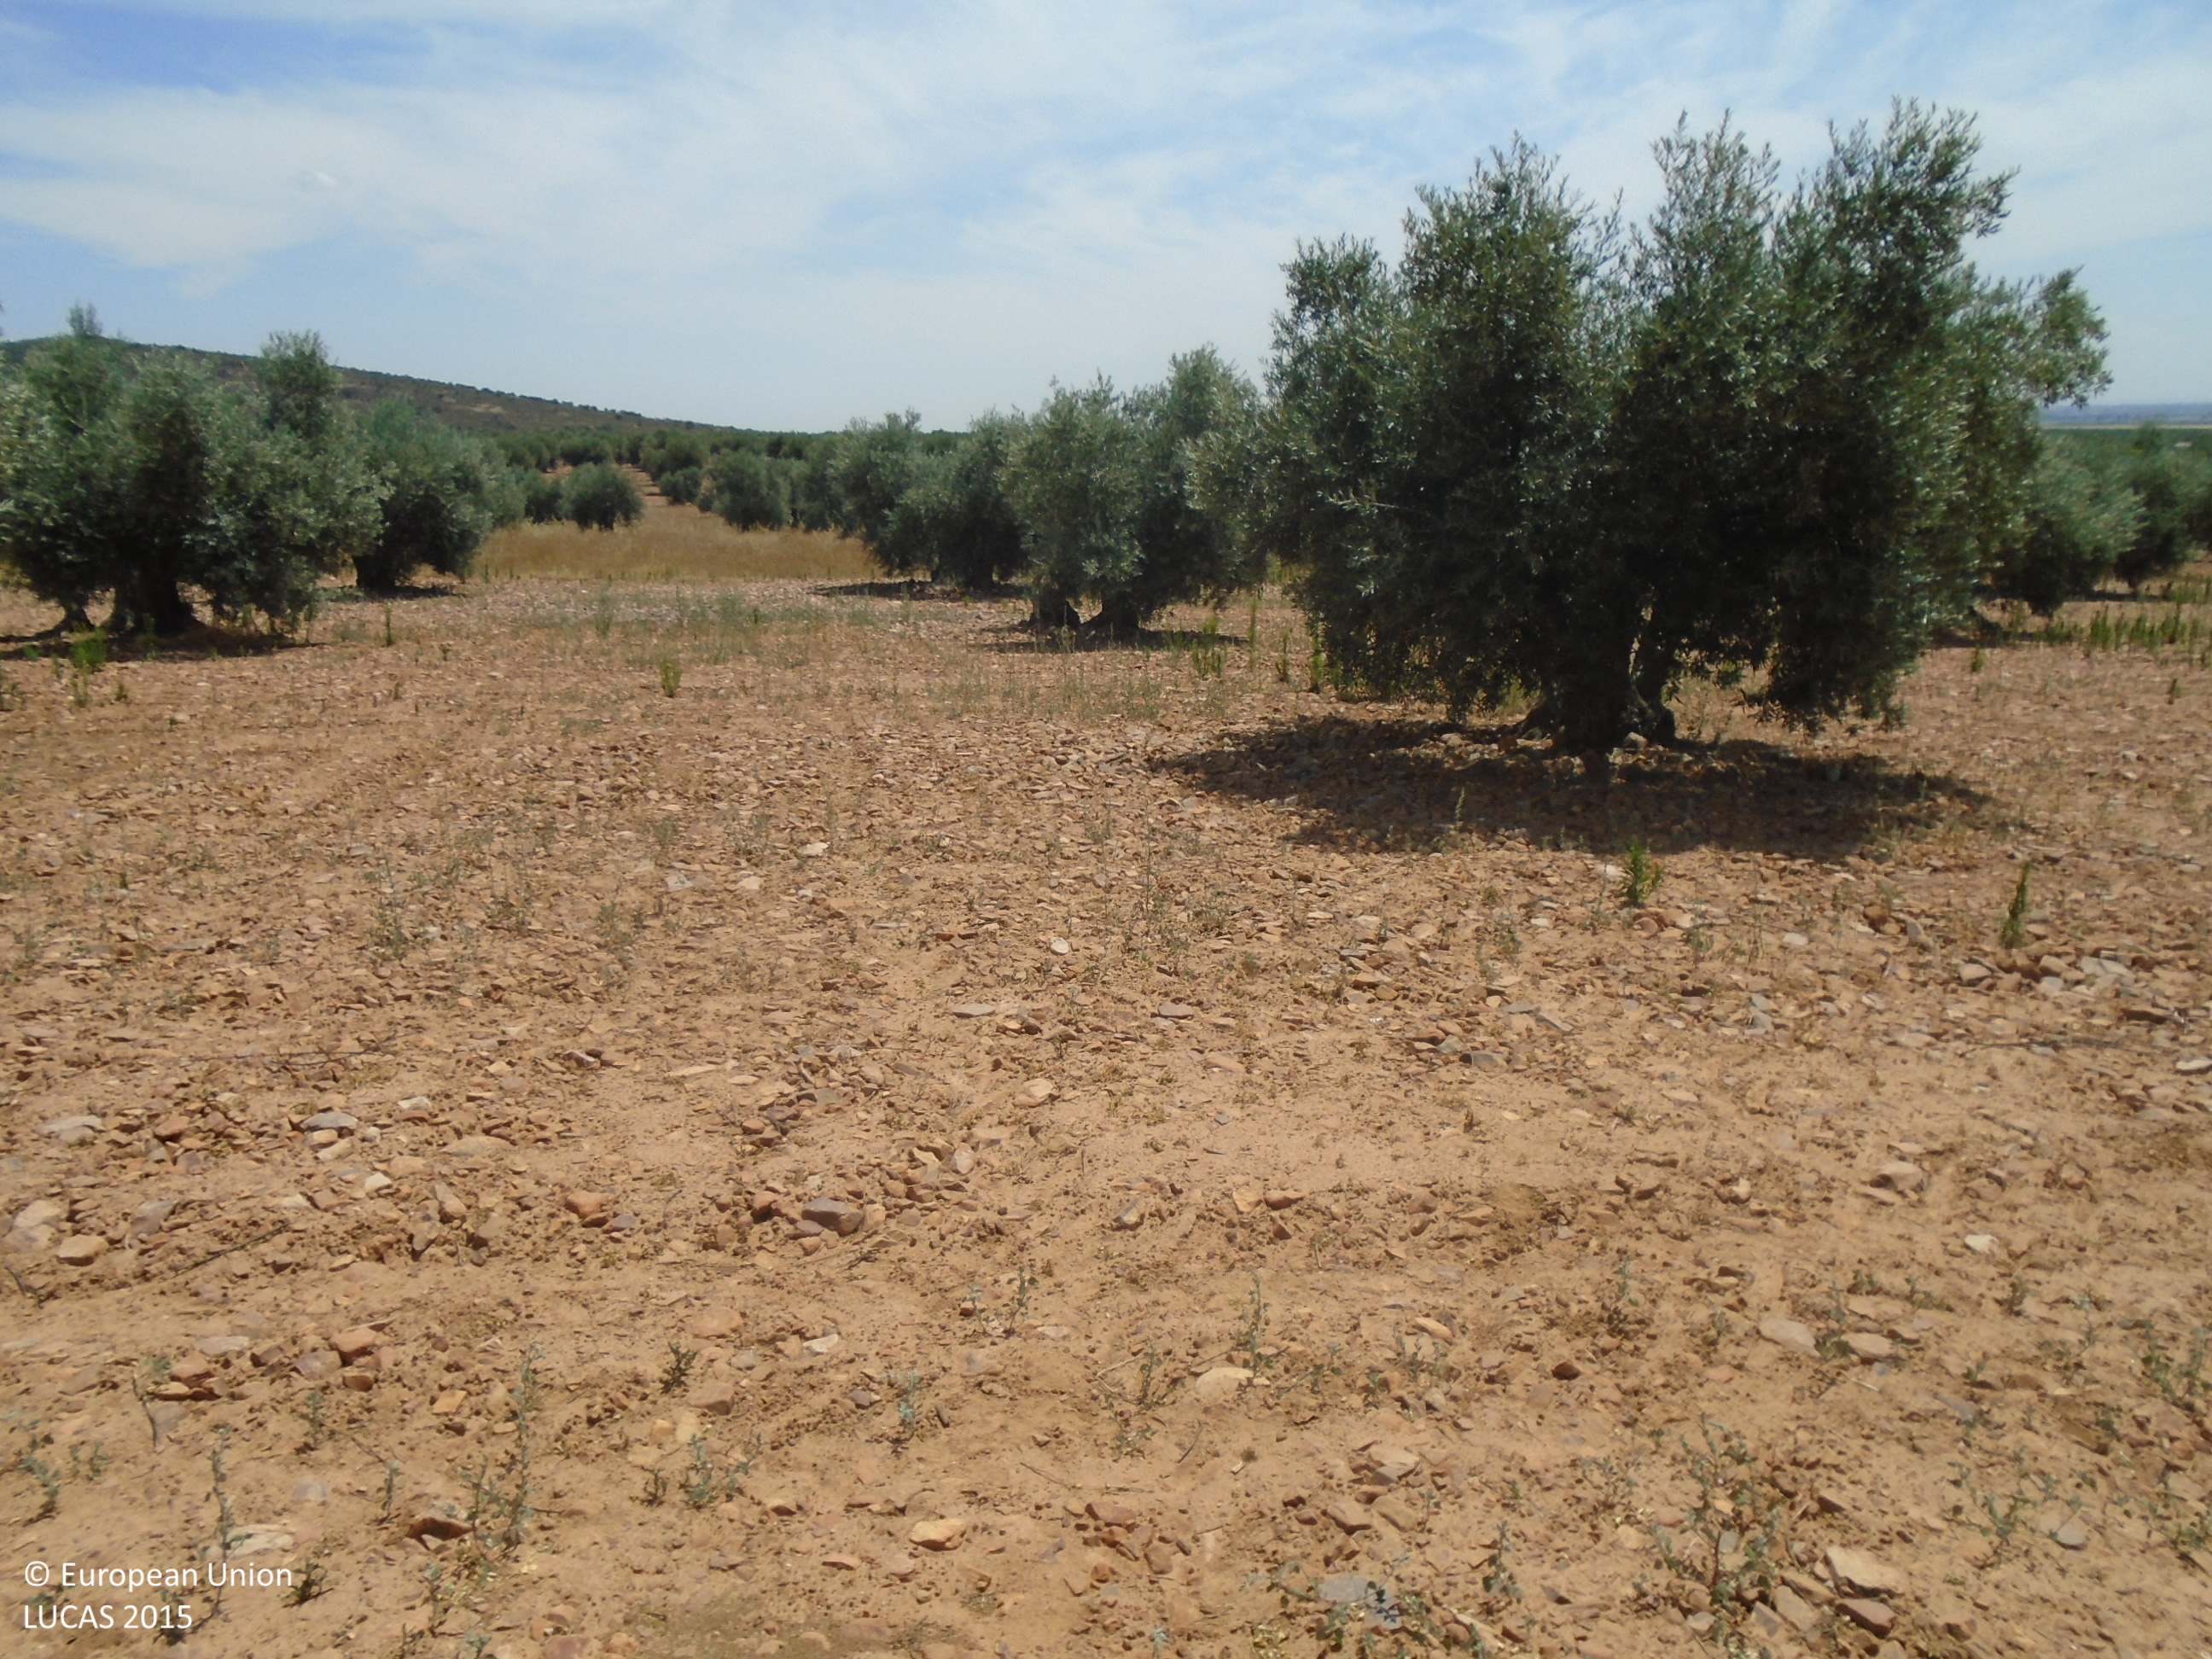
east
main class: Cropland
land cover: Olive groves
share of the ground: 10 - 25 %
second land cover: Other bare soil
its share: > 75 %
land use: Agriculture (excluding fallow land and kitchen gardens)
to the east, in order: Olive groves; Other bare soil; Tracks; Olive groves; Ditches and canals; Tracks; Ditches and canals; Olive groves
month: June
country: ES
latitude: 39.2617
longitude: -3.5917
